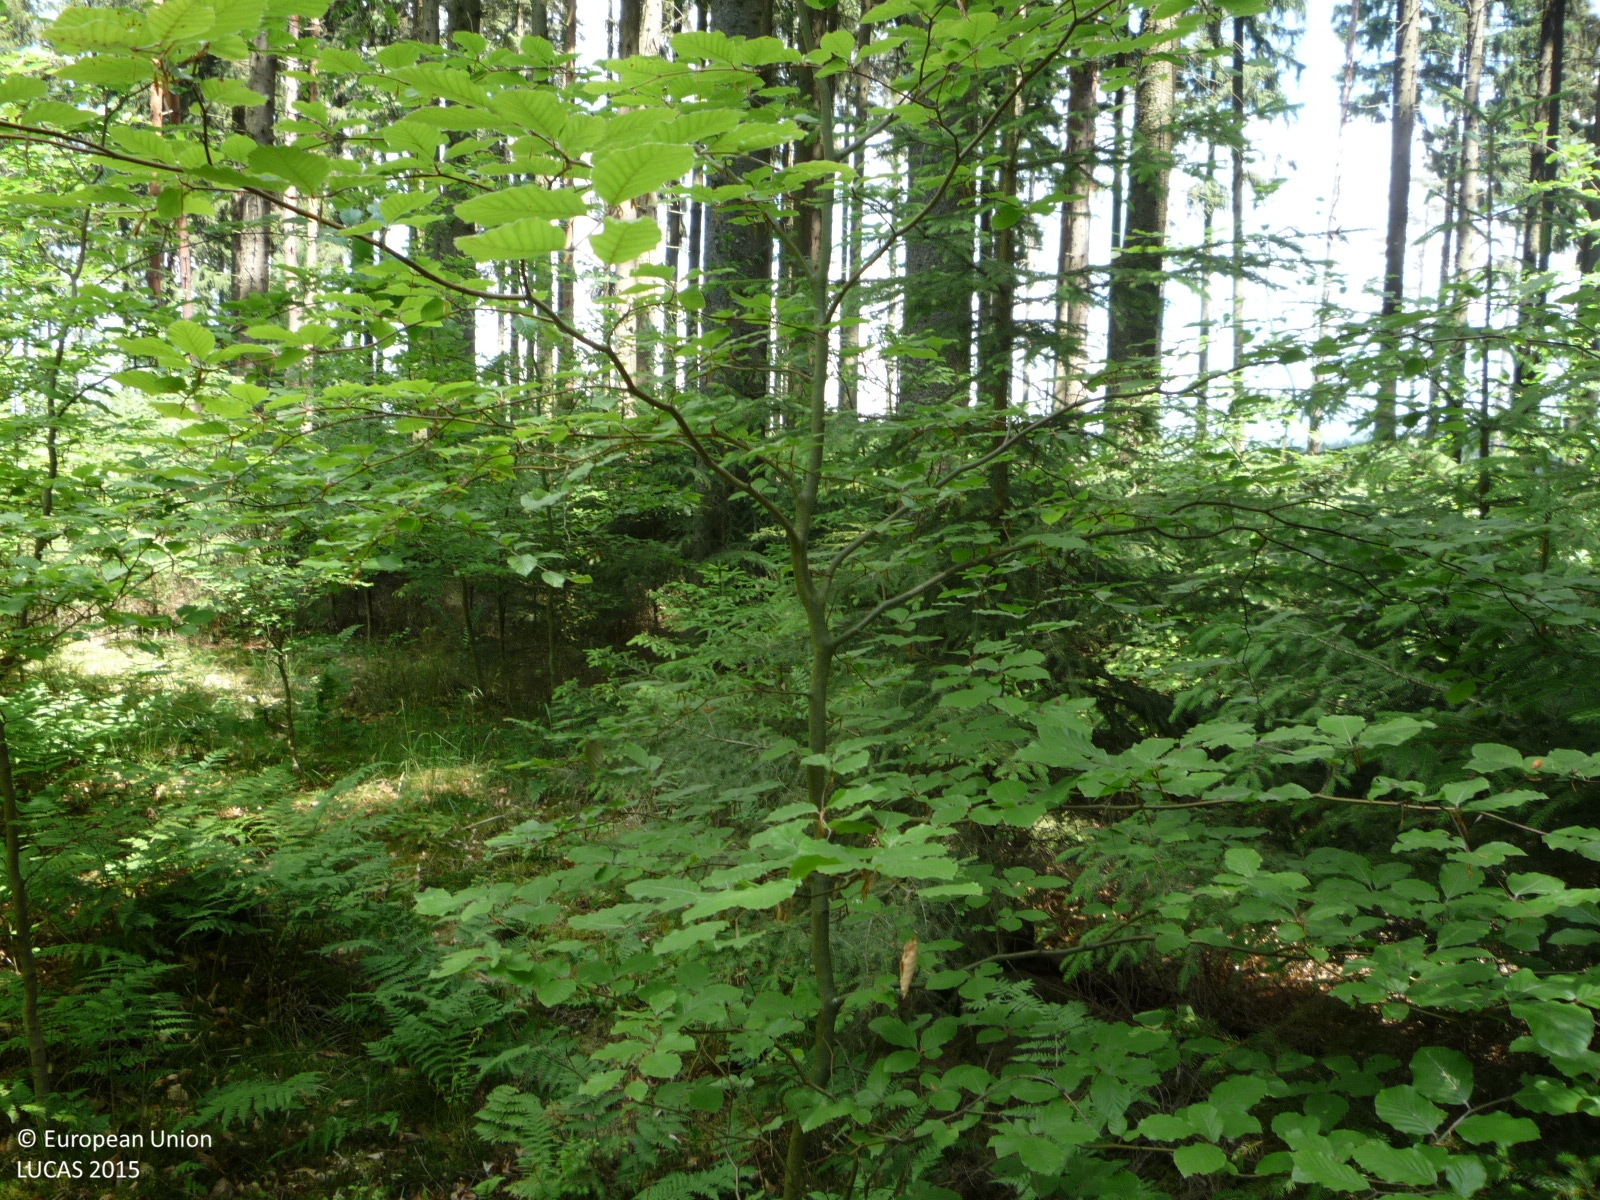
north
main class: Woodland
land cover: Spruce dominated mixed woodland
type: hemiboreal forest and nemoral coniferous forest and mixed broadleaved-coniferous forest
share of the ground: > 75 %
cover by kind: broadleaved forest trees 45 %, coniferous forest trees 40 %, lichens and mosses 10 %, unconsolidated bare surface 5 %
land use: Forestry
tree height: > 5 m
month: June
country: CZ
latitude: 49.7064
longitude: 15.1752
